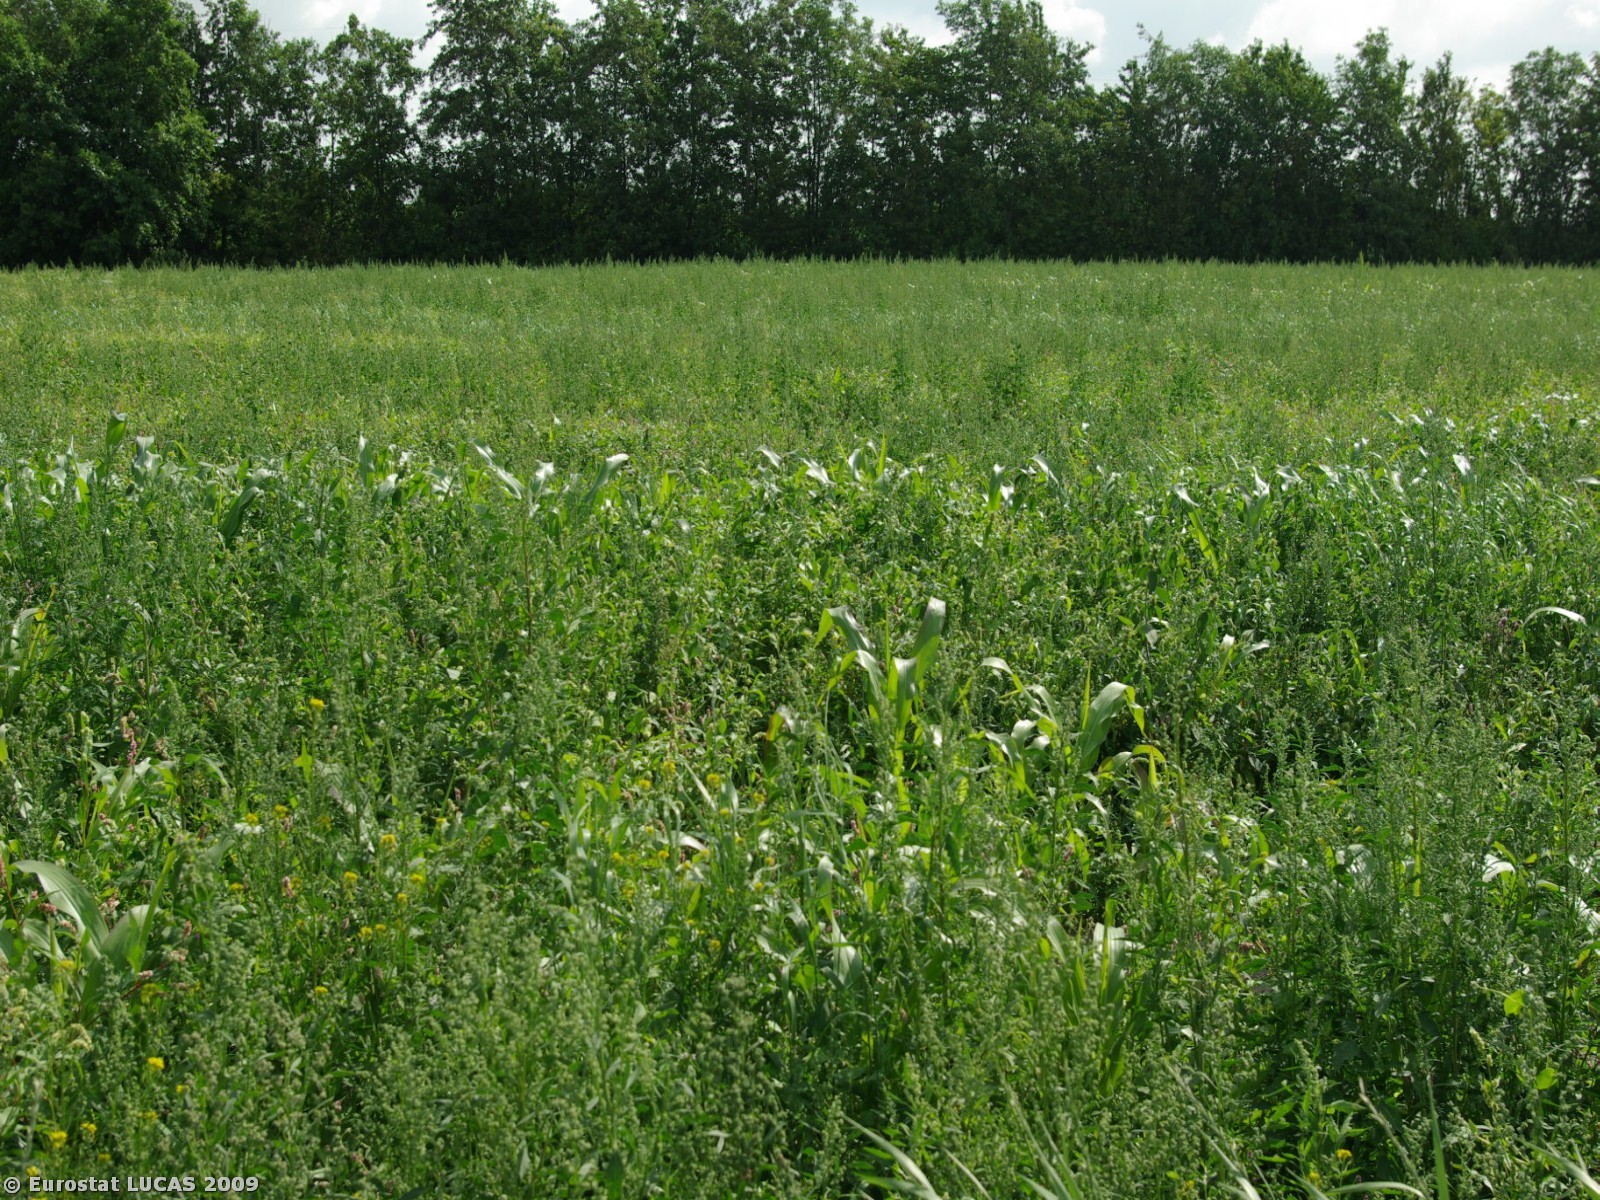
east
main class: Cropland
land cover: Maize
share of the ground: 10 - 25 %
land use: Agriculture (excluding fallow land and kitchen gardens)
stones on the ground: < 10 %
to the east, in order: Maize; Broadleaved woodland; Tracks; Broadleaved woodland; Maize; Broadleaved woodland; Tracks; Maize
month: July
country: DK
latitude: 54.9096
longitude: 9.2986
